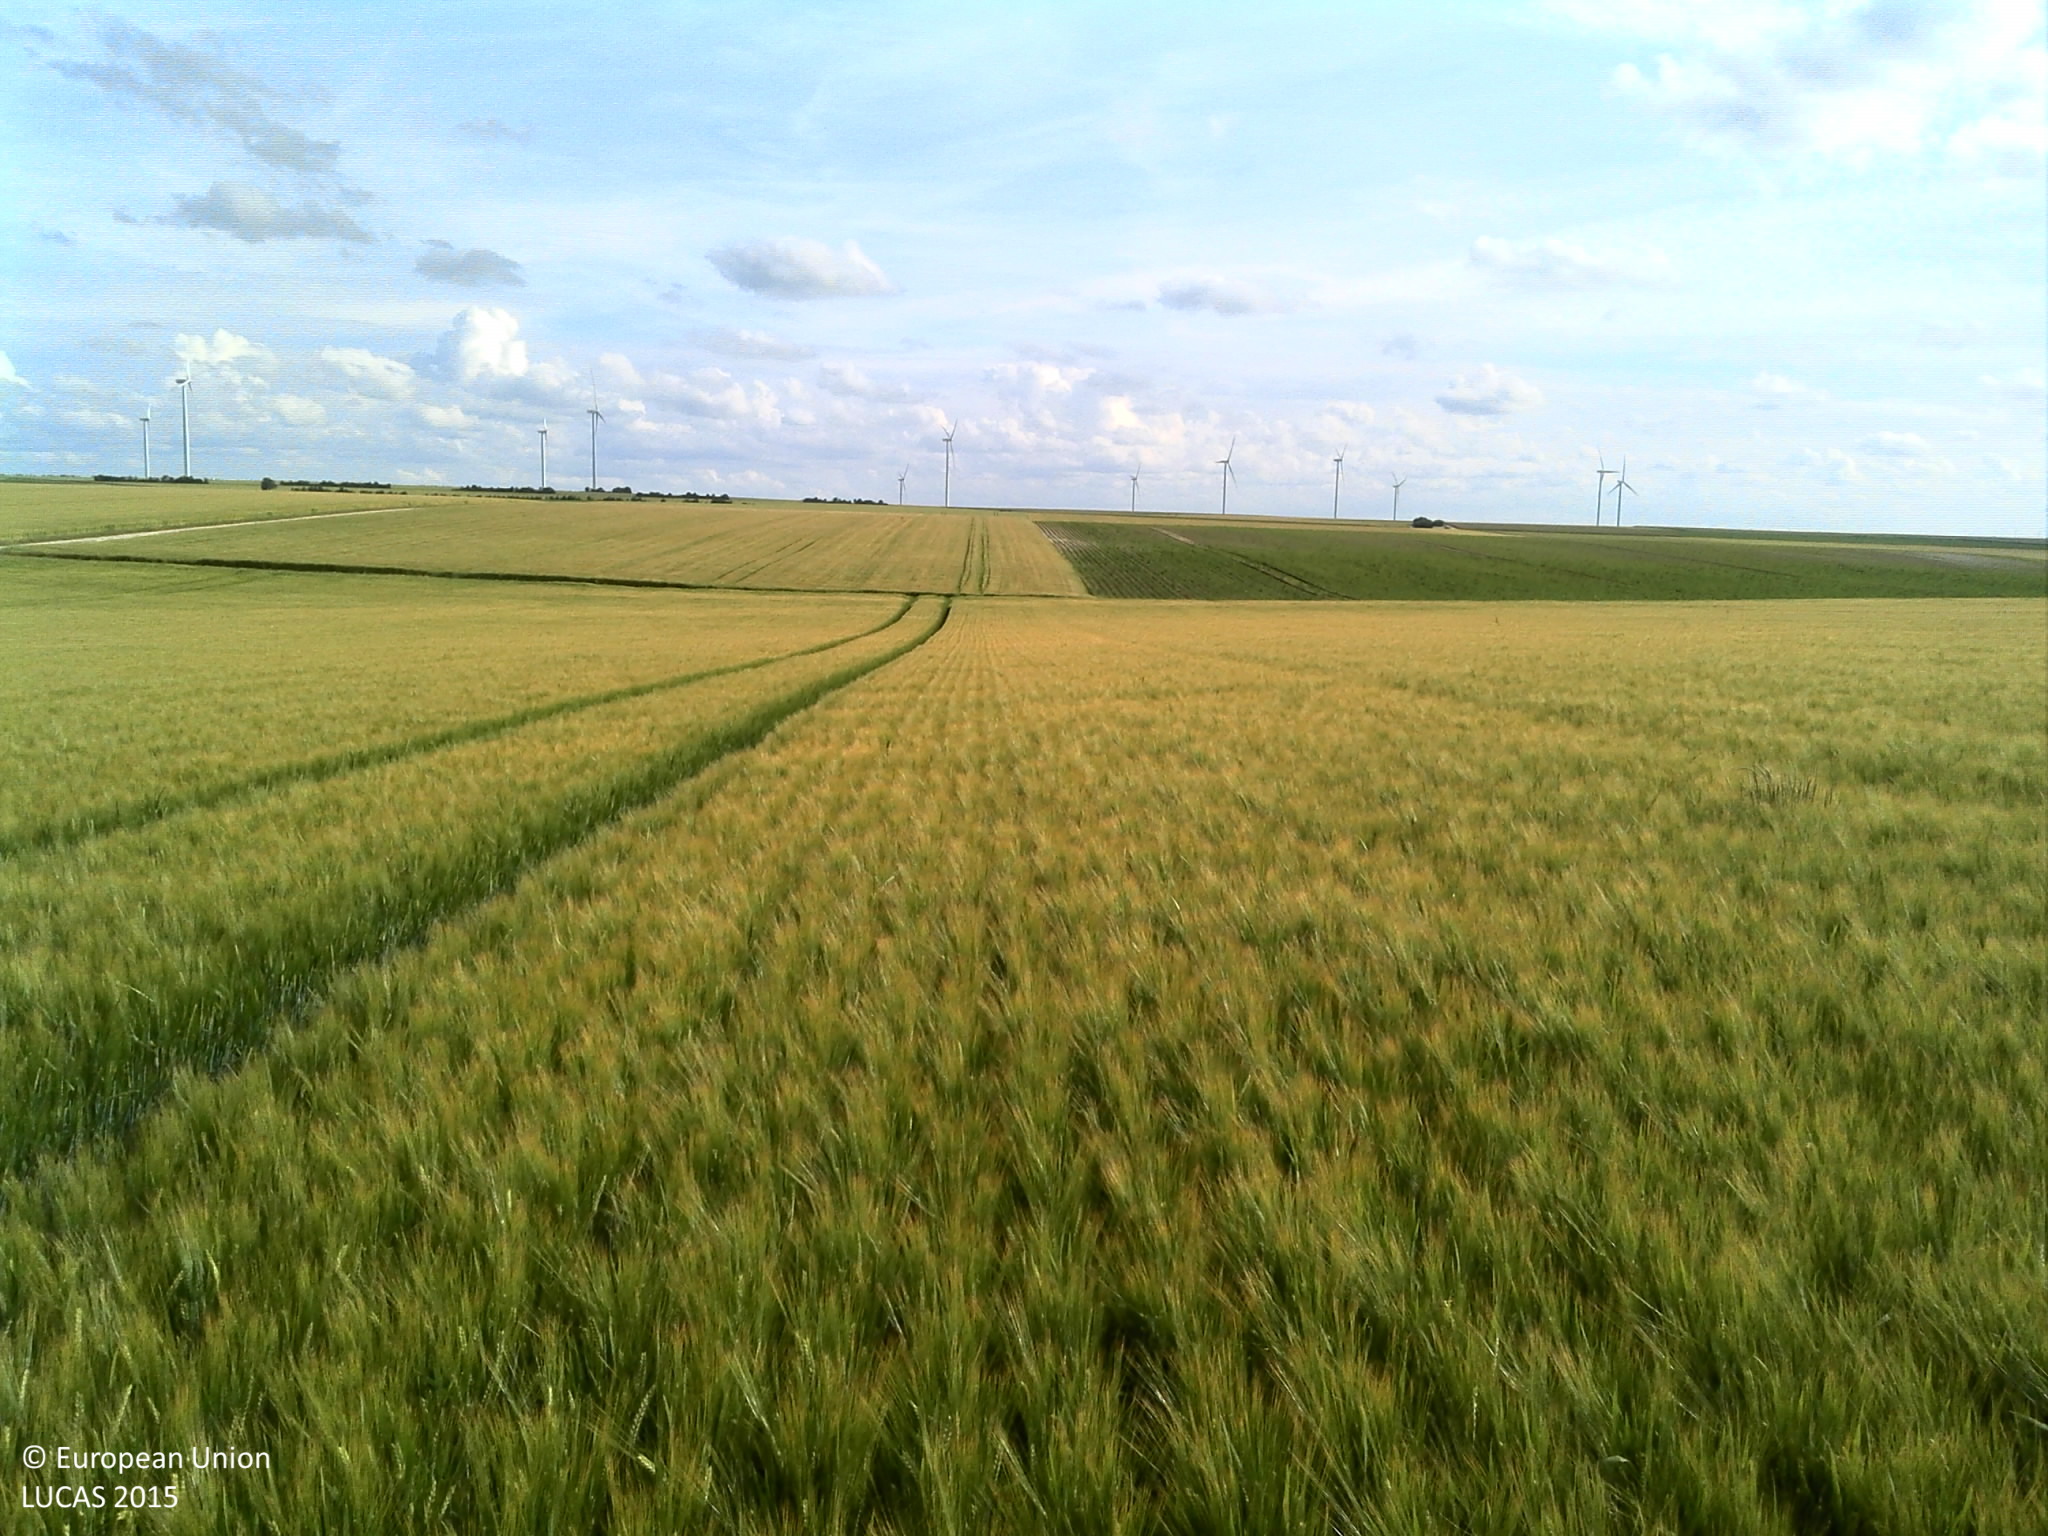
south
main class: Cropland
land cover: Barley
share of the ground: > 75 %
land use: Agriculture (excluding fallow land and kitchen gardens)
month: June
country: FR
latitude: 48.6274
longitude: 4.1484
